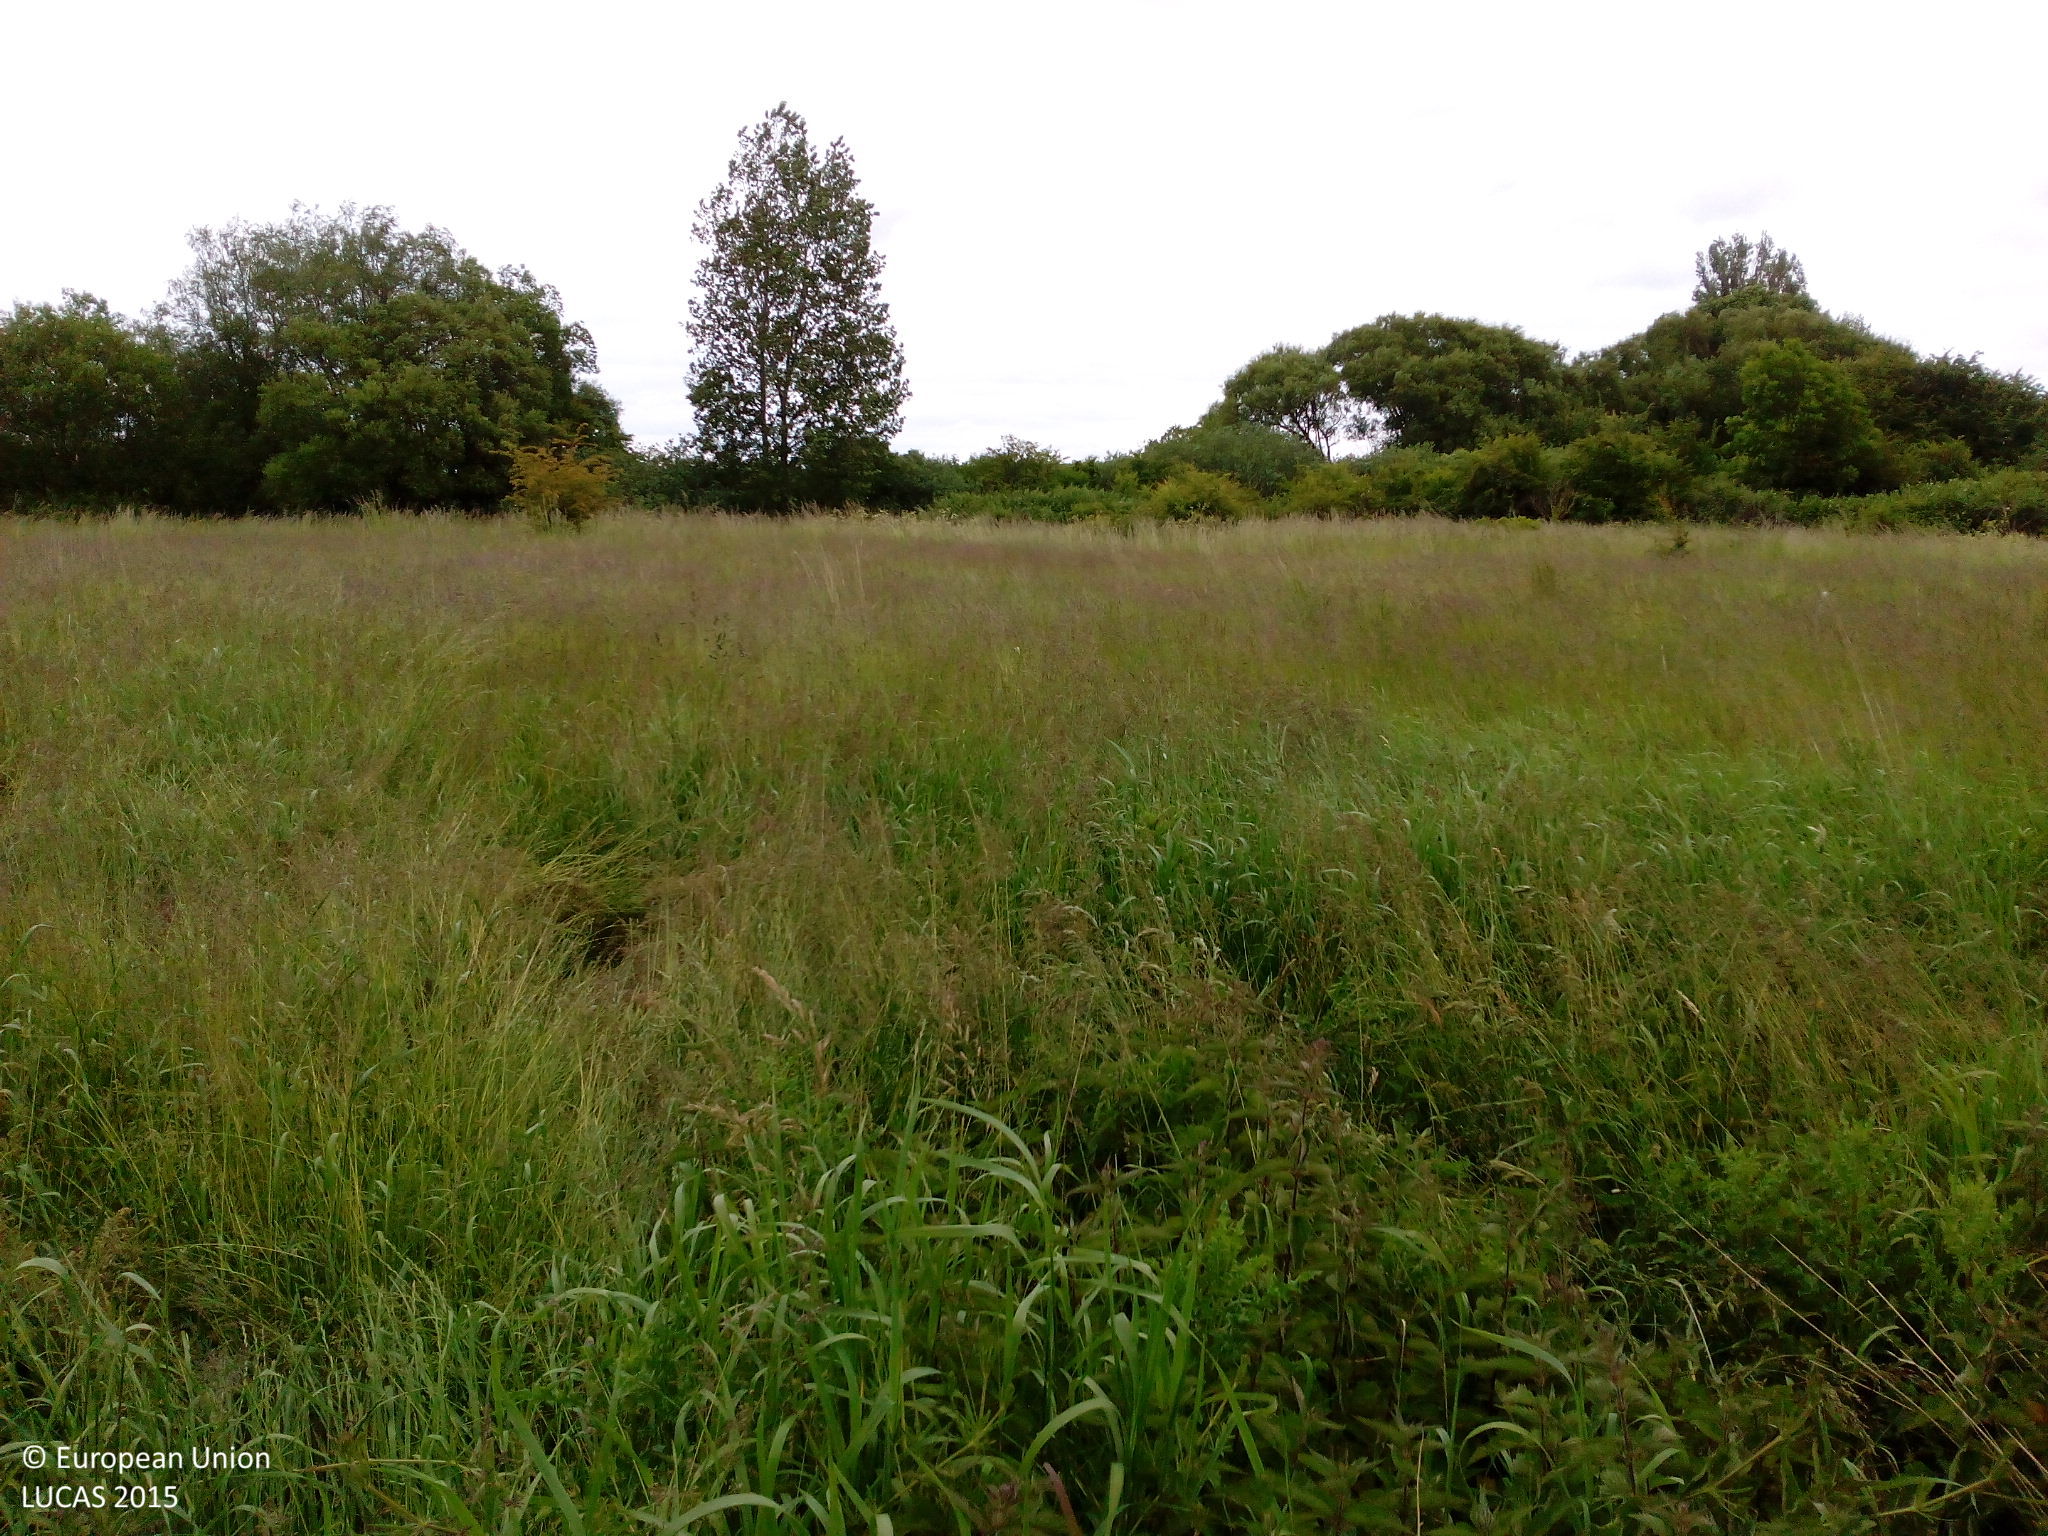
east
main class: Grassland
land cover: Spontaneously vegetated surfaces
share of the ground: > 75 %
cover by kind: herbaceous plants 100 %
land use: Semi-natural and natural areas not in use
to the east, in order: Spontaneously vegetated surfaces; Broadleaved woodland; Inland marshes; Inland fresh water bodies; Inland marshes; Broadleaved woodland; Spontaneously vegetated surfaces
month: June
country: DK
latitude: 54.9454
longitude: 10.7332
